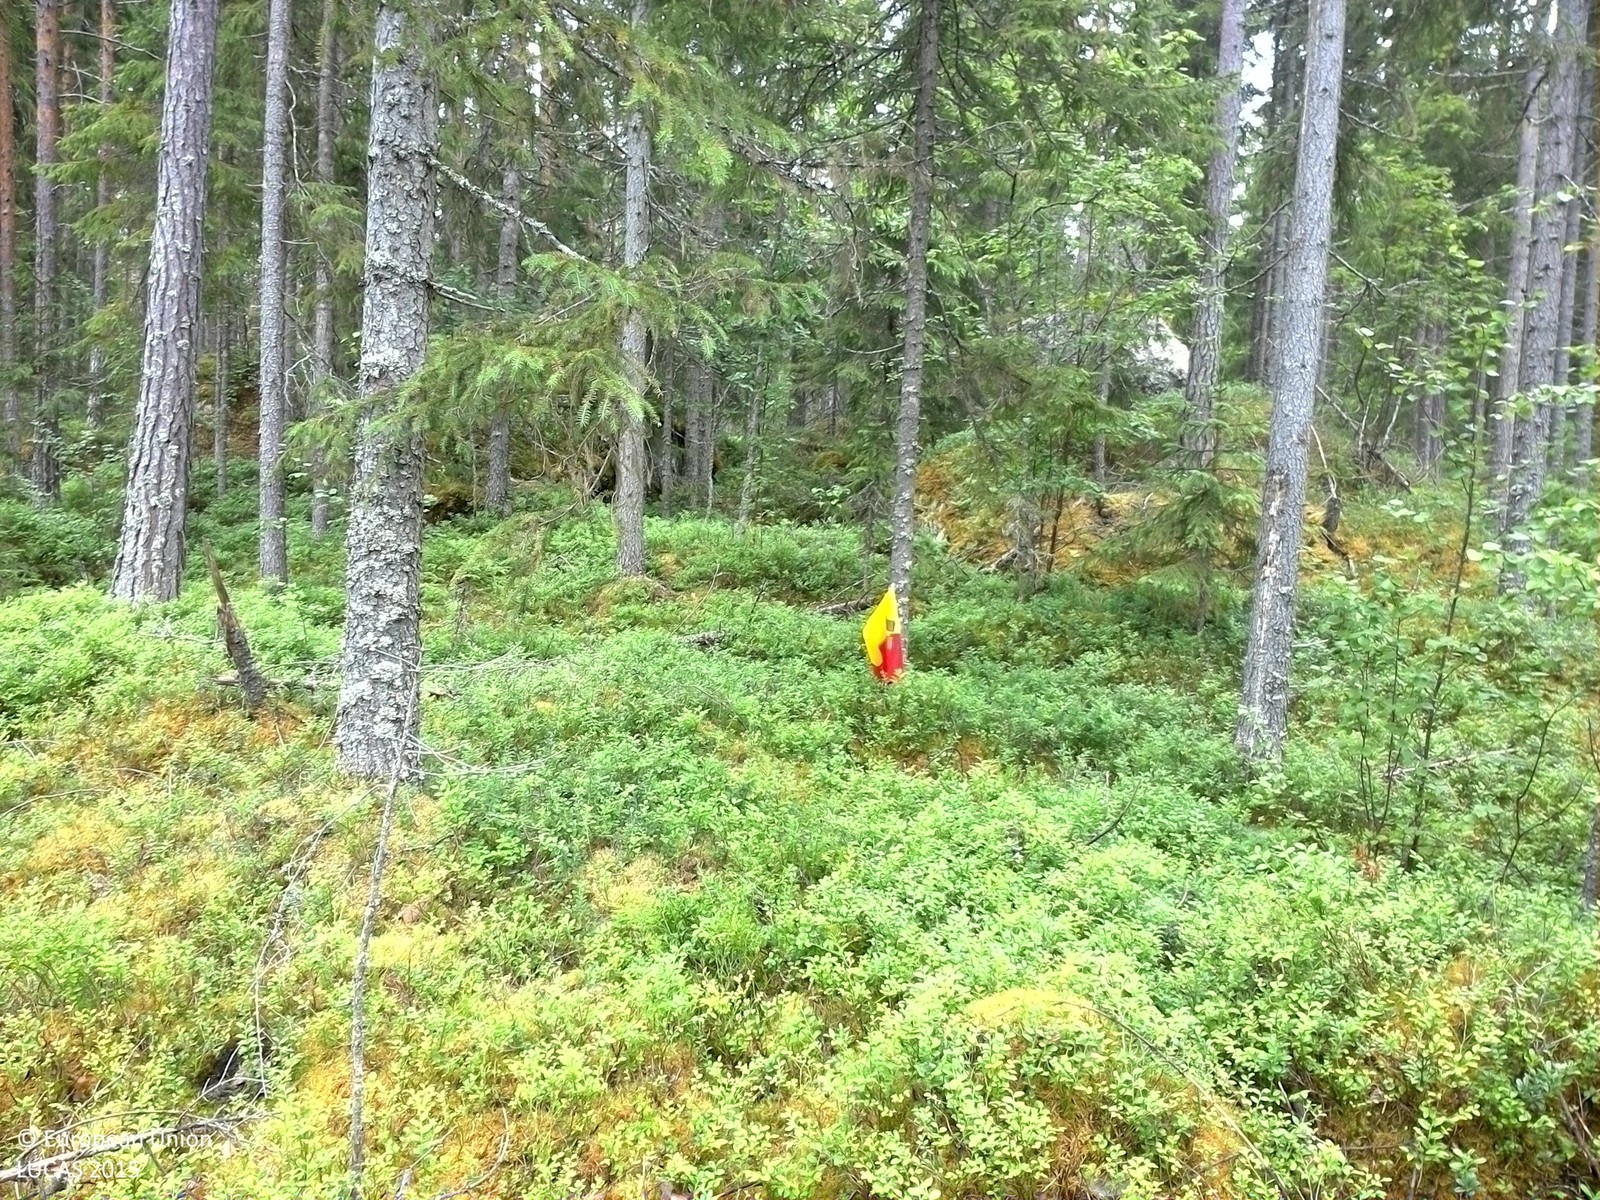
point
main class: Woodland
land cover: Pine dominated coniferous woodland
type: boreal forest
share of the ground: 25 - 50 %
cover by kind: coniferous forest trees 40 %, shrubs 35 %, lichens and mosses 15 %, broadleaved forest trees 5 %, consolidated bare surface 5 %
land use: Forestry
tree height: > 5 m
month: August
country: SE
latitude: 63.5676
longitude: 16.2760
